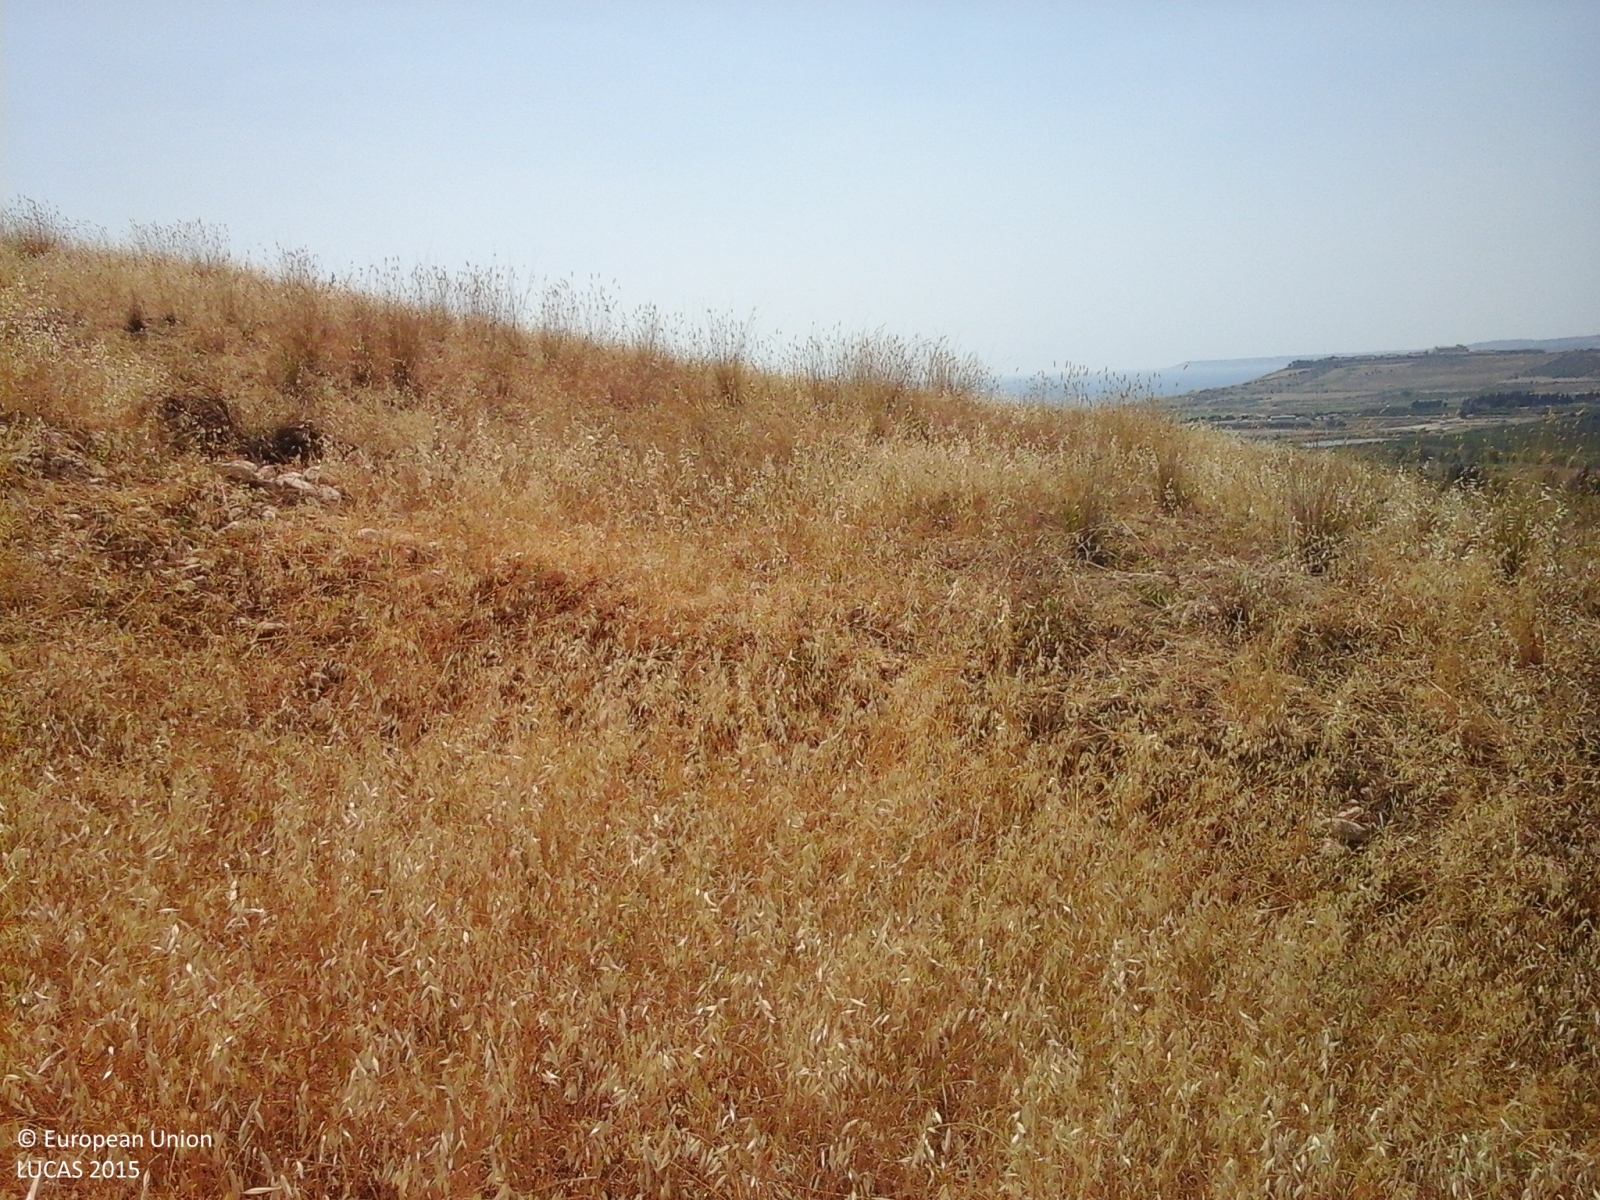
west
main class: Grassland
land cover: Spontaneously vegetated surfaces
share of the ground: > 75 %
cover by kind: herbaceous plants 100 %
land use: Fallow land
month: July
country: IT
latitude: 37.4750
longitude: 13.2205
